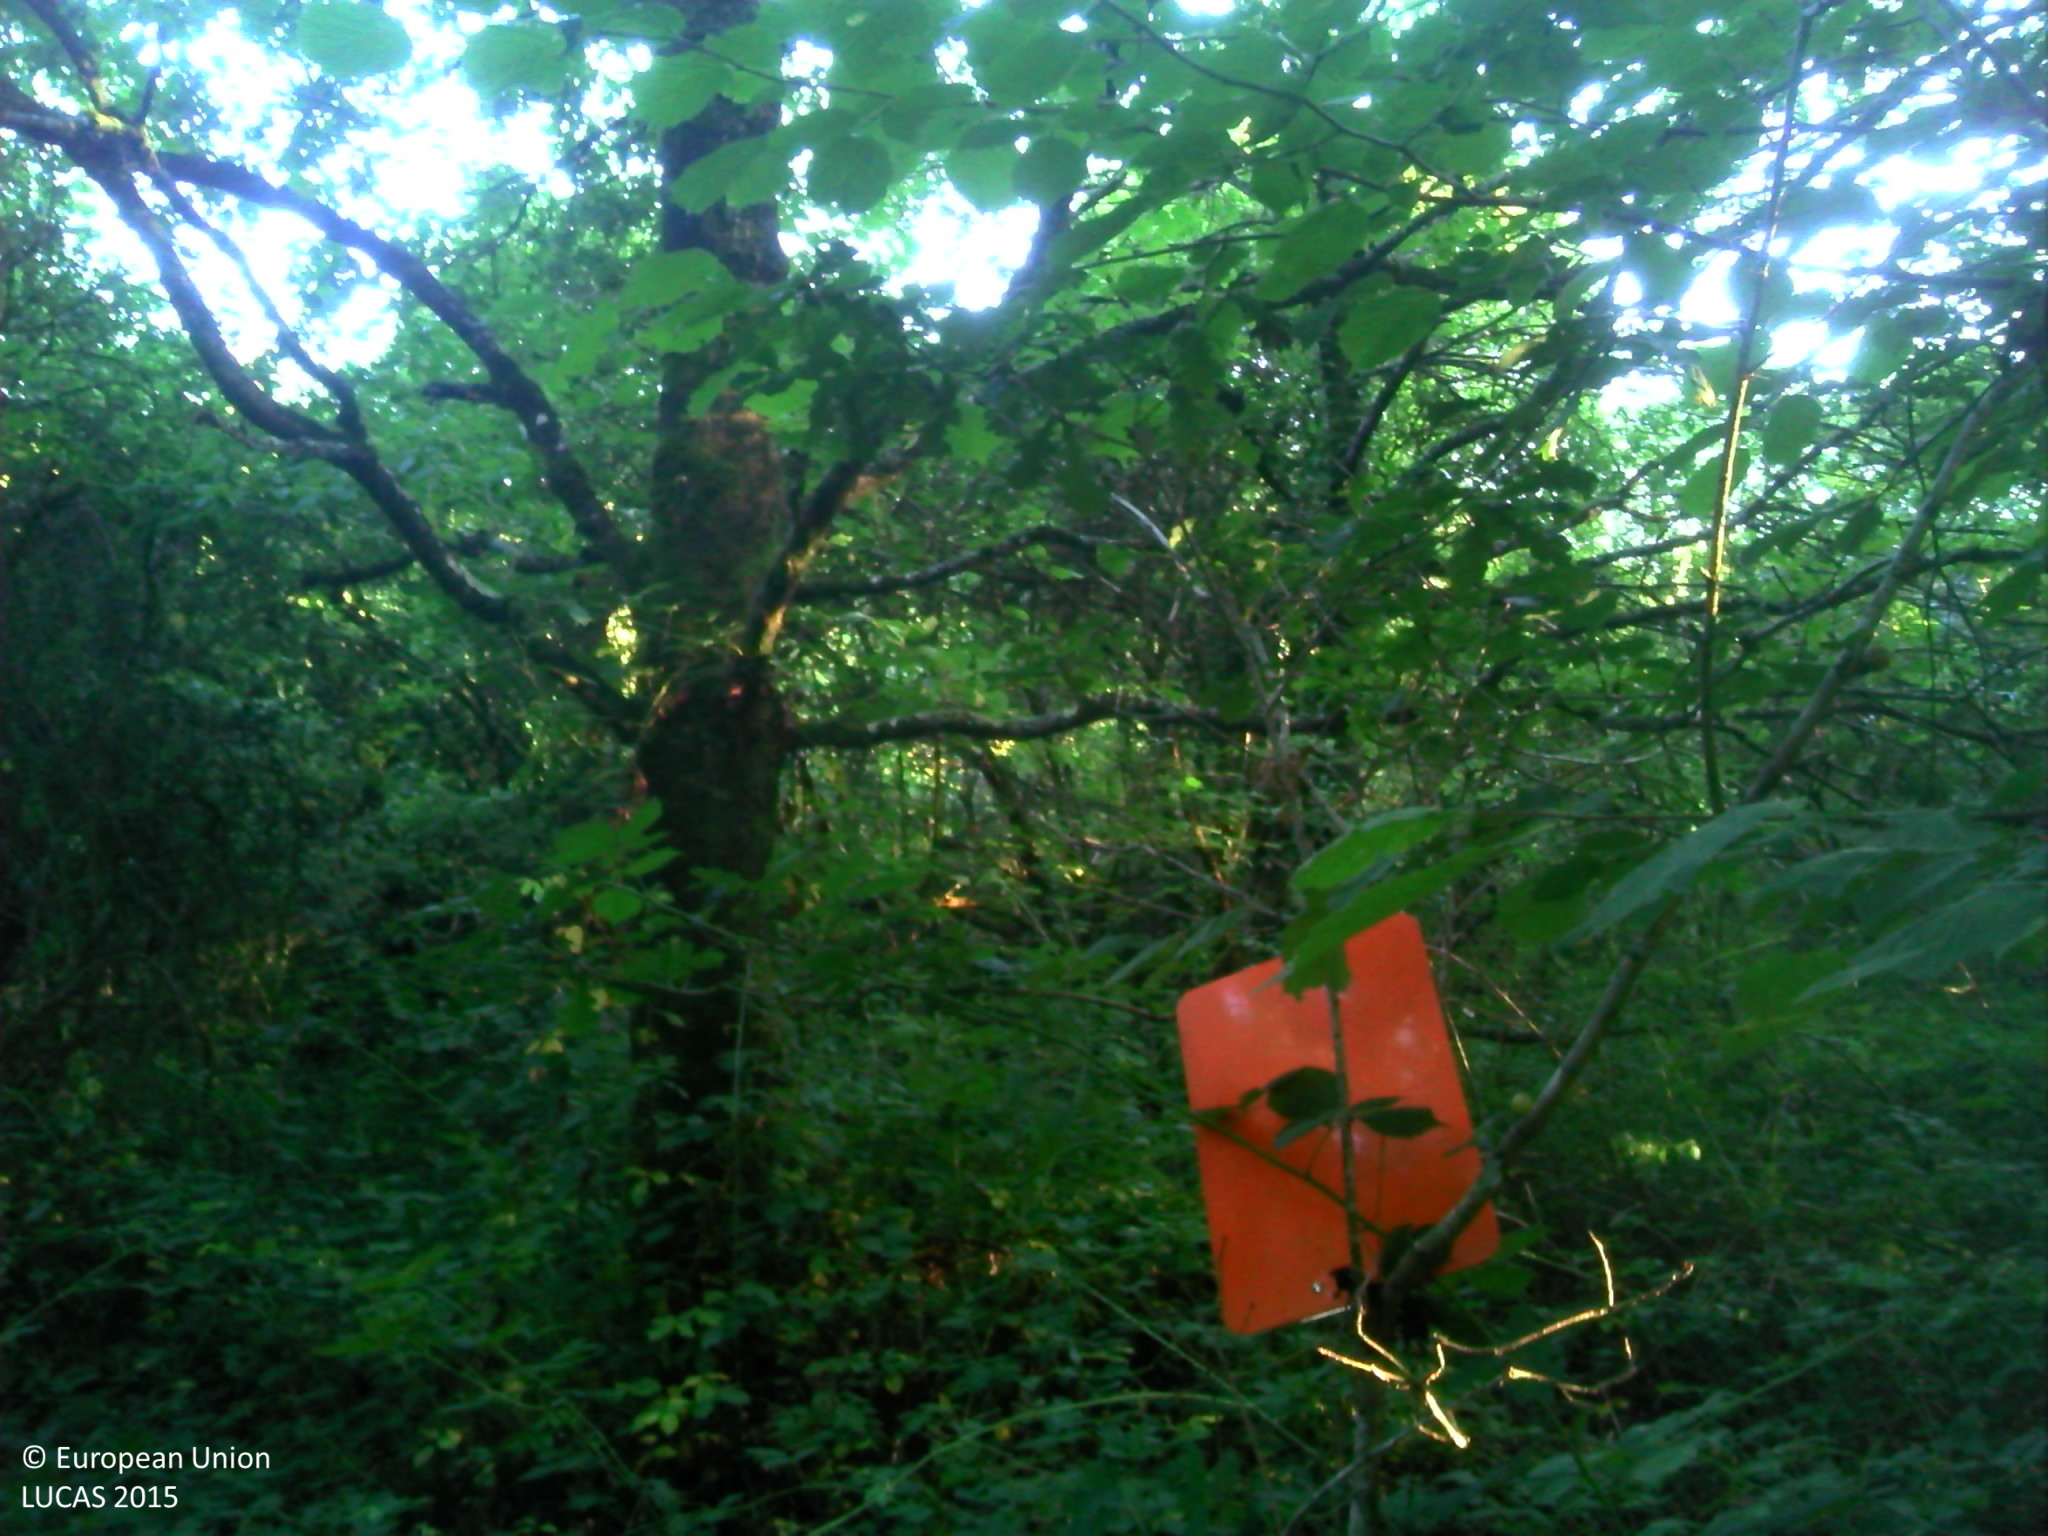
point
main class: Woodland
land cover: Broadleaved woodland
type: mesophytic deciduous forest
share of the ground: > 75 %
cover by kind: broadleaved forest trees 95 %, shrubs 5 %
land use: Forestry
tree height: > 5 m
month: July
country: FR
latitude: 46.8661
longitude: -0.8813
